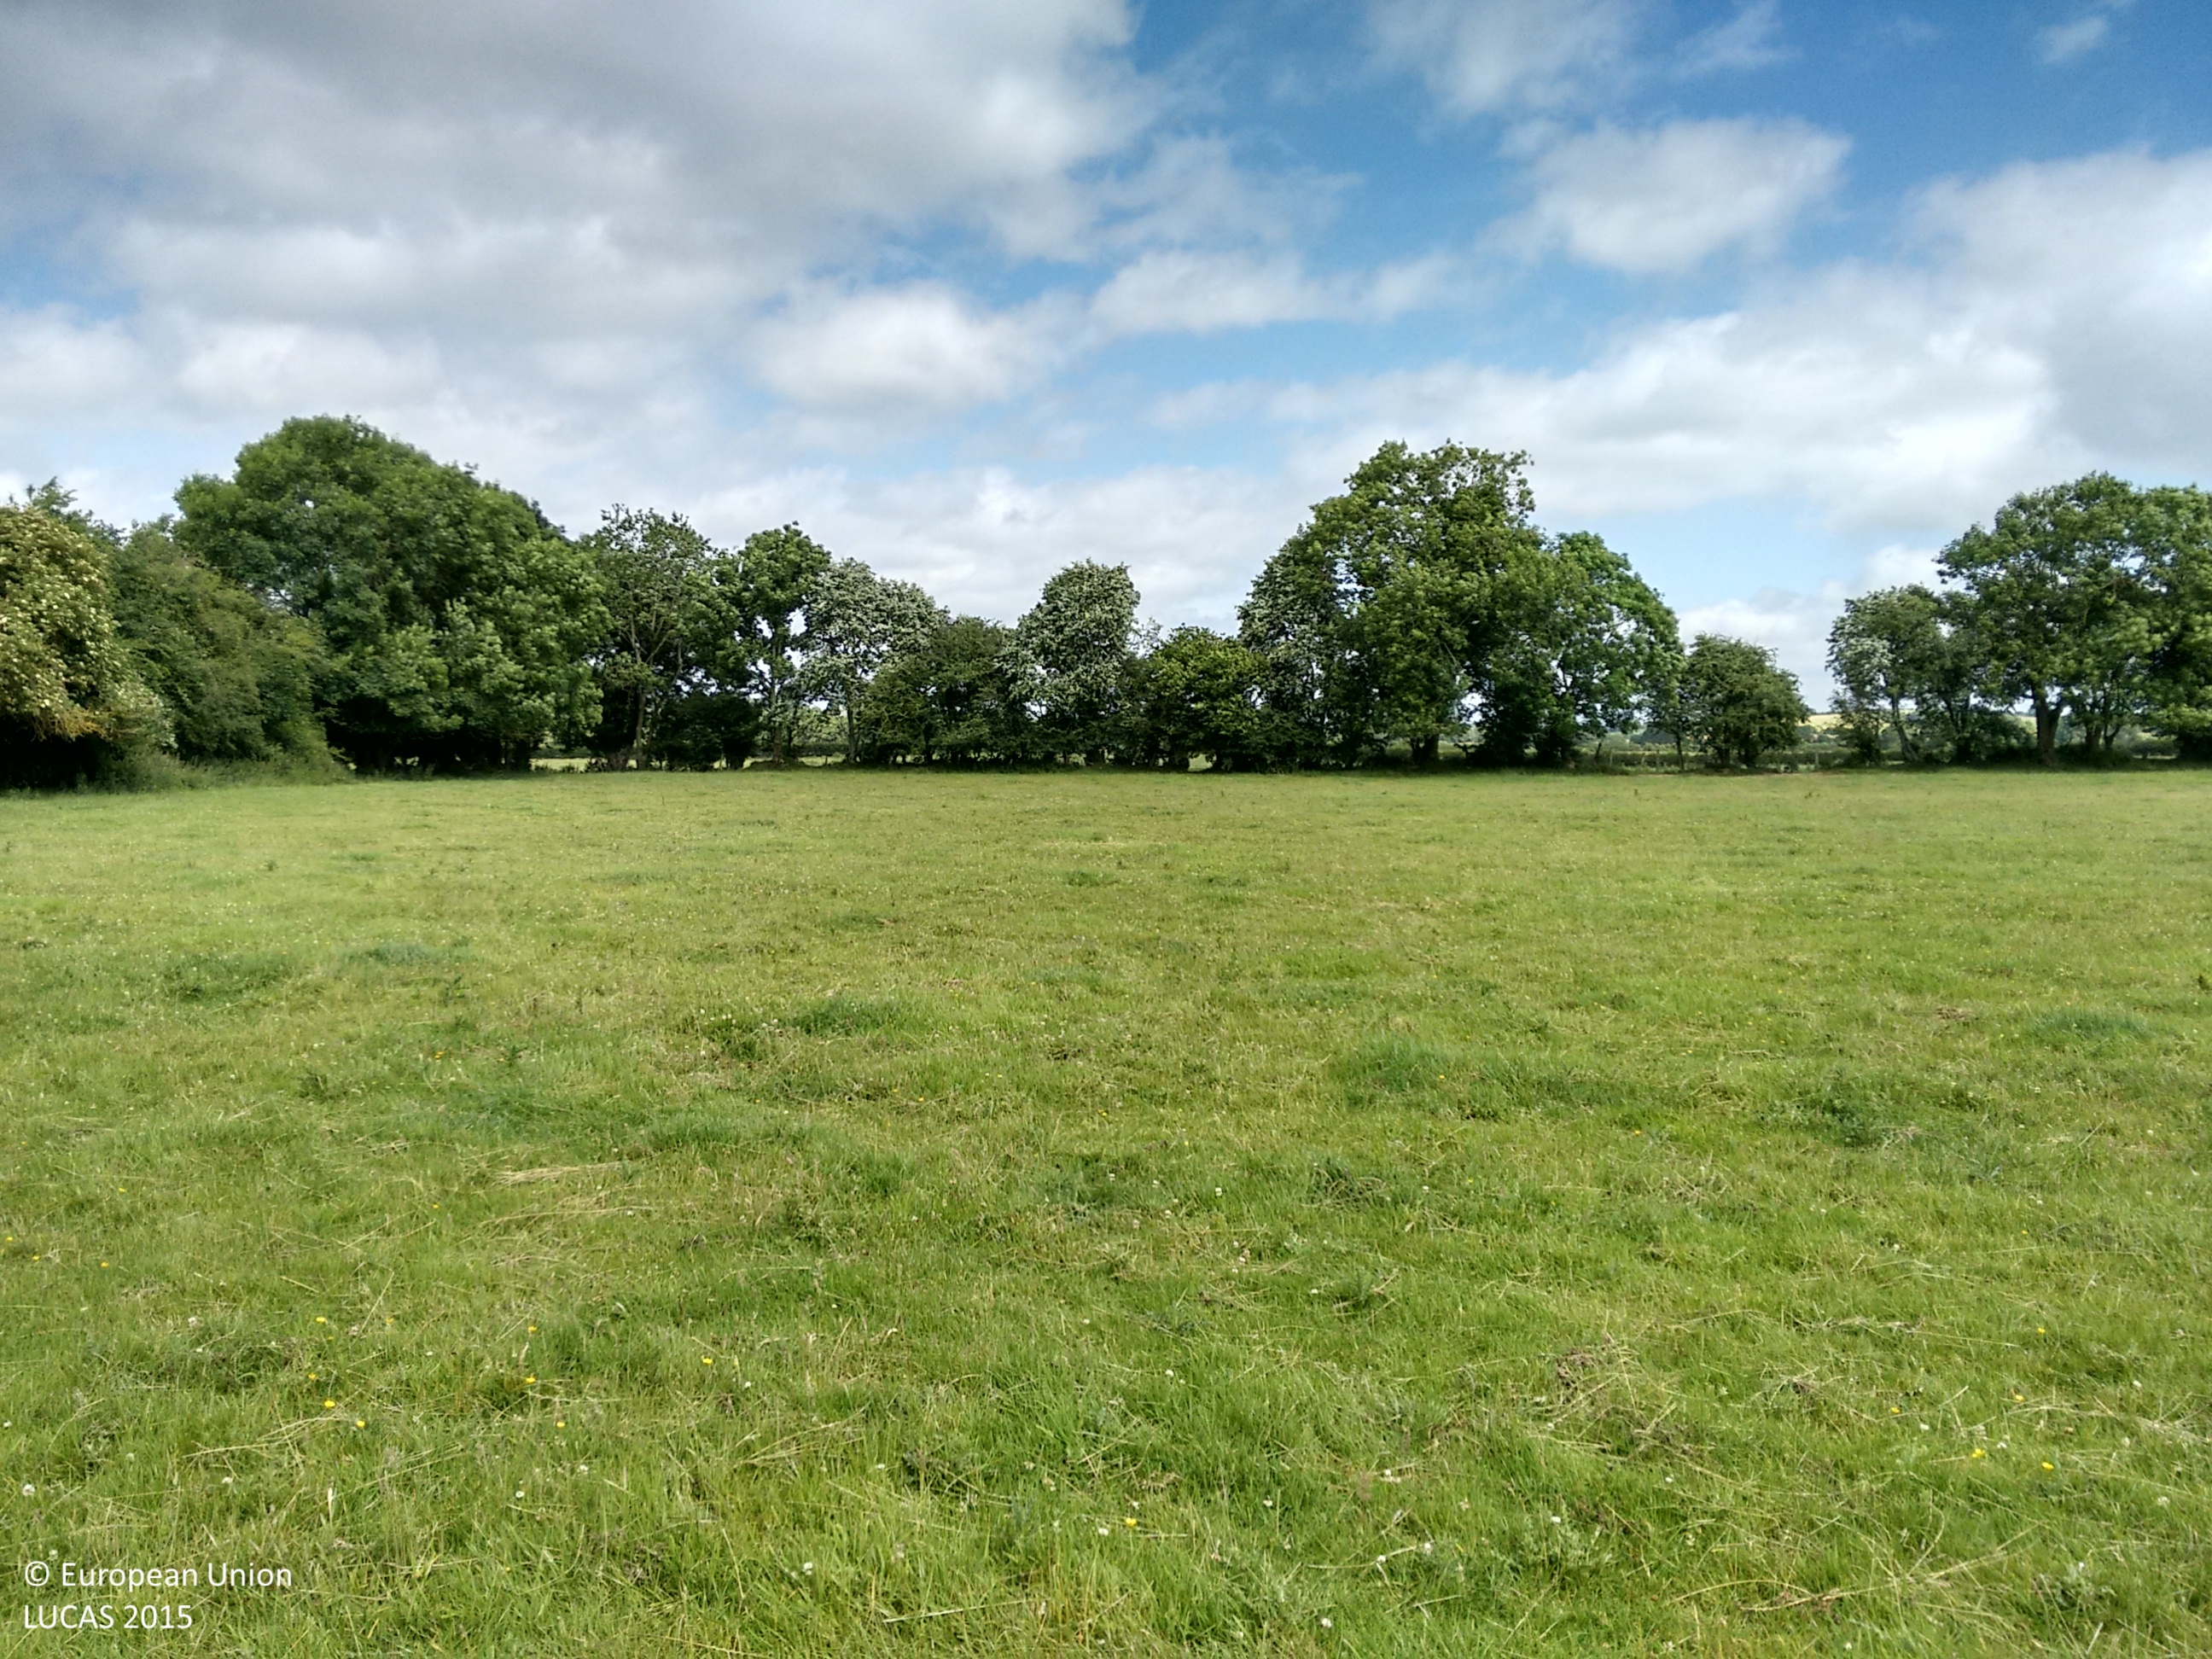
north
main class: Grassland
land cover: Grassland without tree/shrub cover
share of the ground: > 75 %
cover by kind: herbaceous plants 100 %
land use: Agriculture (excluding fallow land and kitchen gardens)
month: July
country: IE
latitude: 53.0827
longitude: -6.7817
